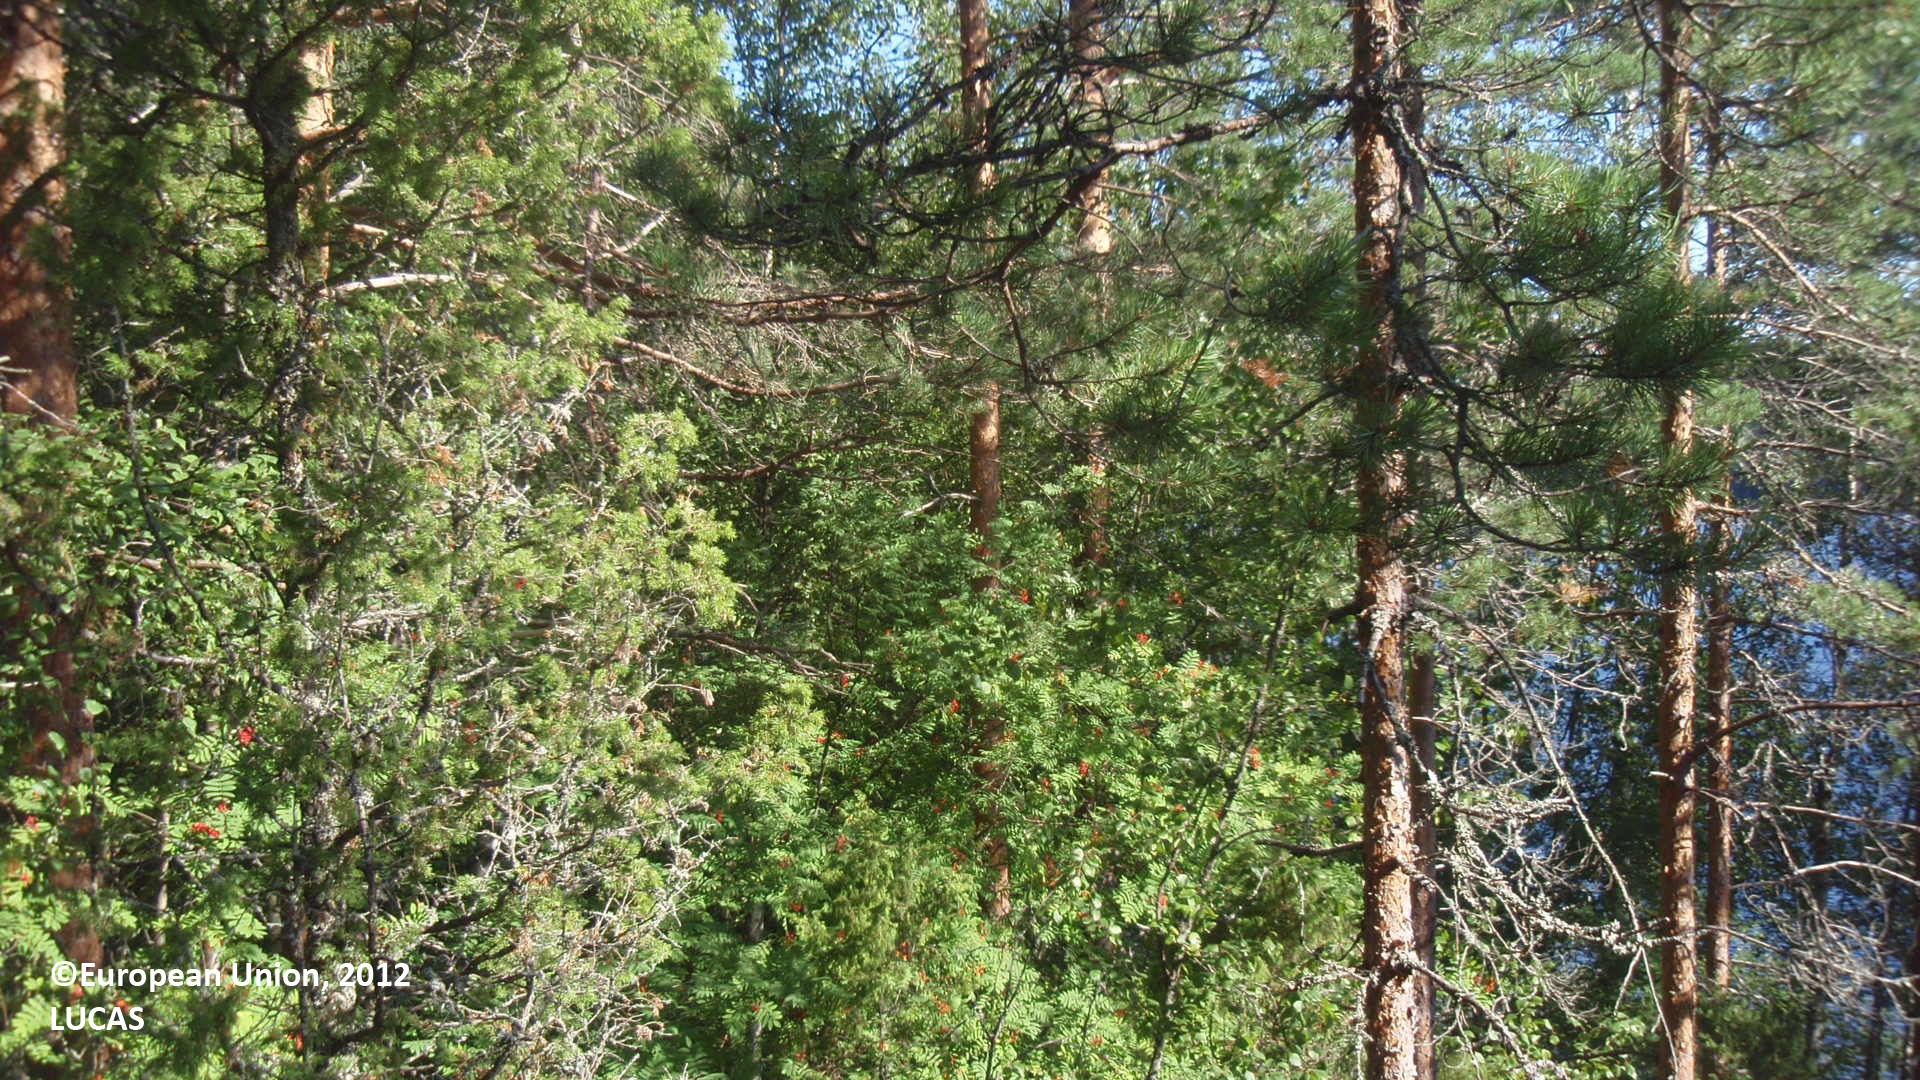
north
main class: Woodland
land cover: Pine dominated coniferous woodland
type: boreal forest
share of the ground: 50 - 75 %
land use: Forestry
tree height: > 5 m
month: August
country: FI
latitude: 61.4358
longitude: 27.8699
